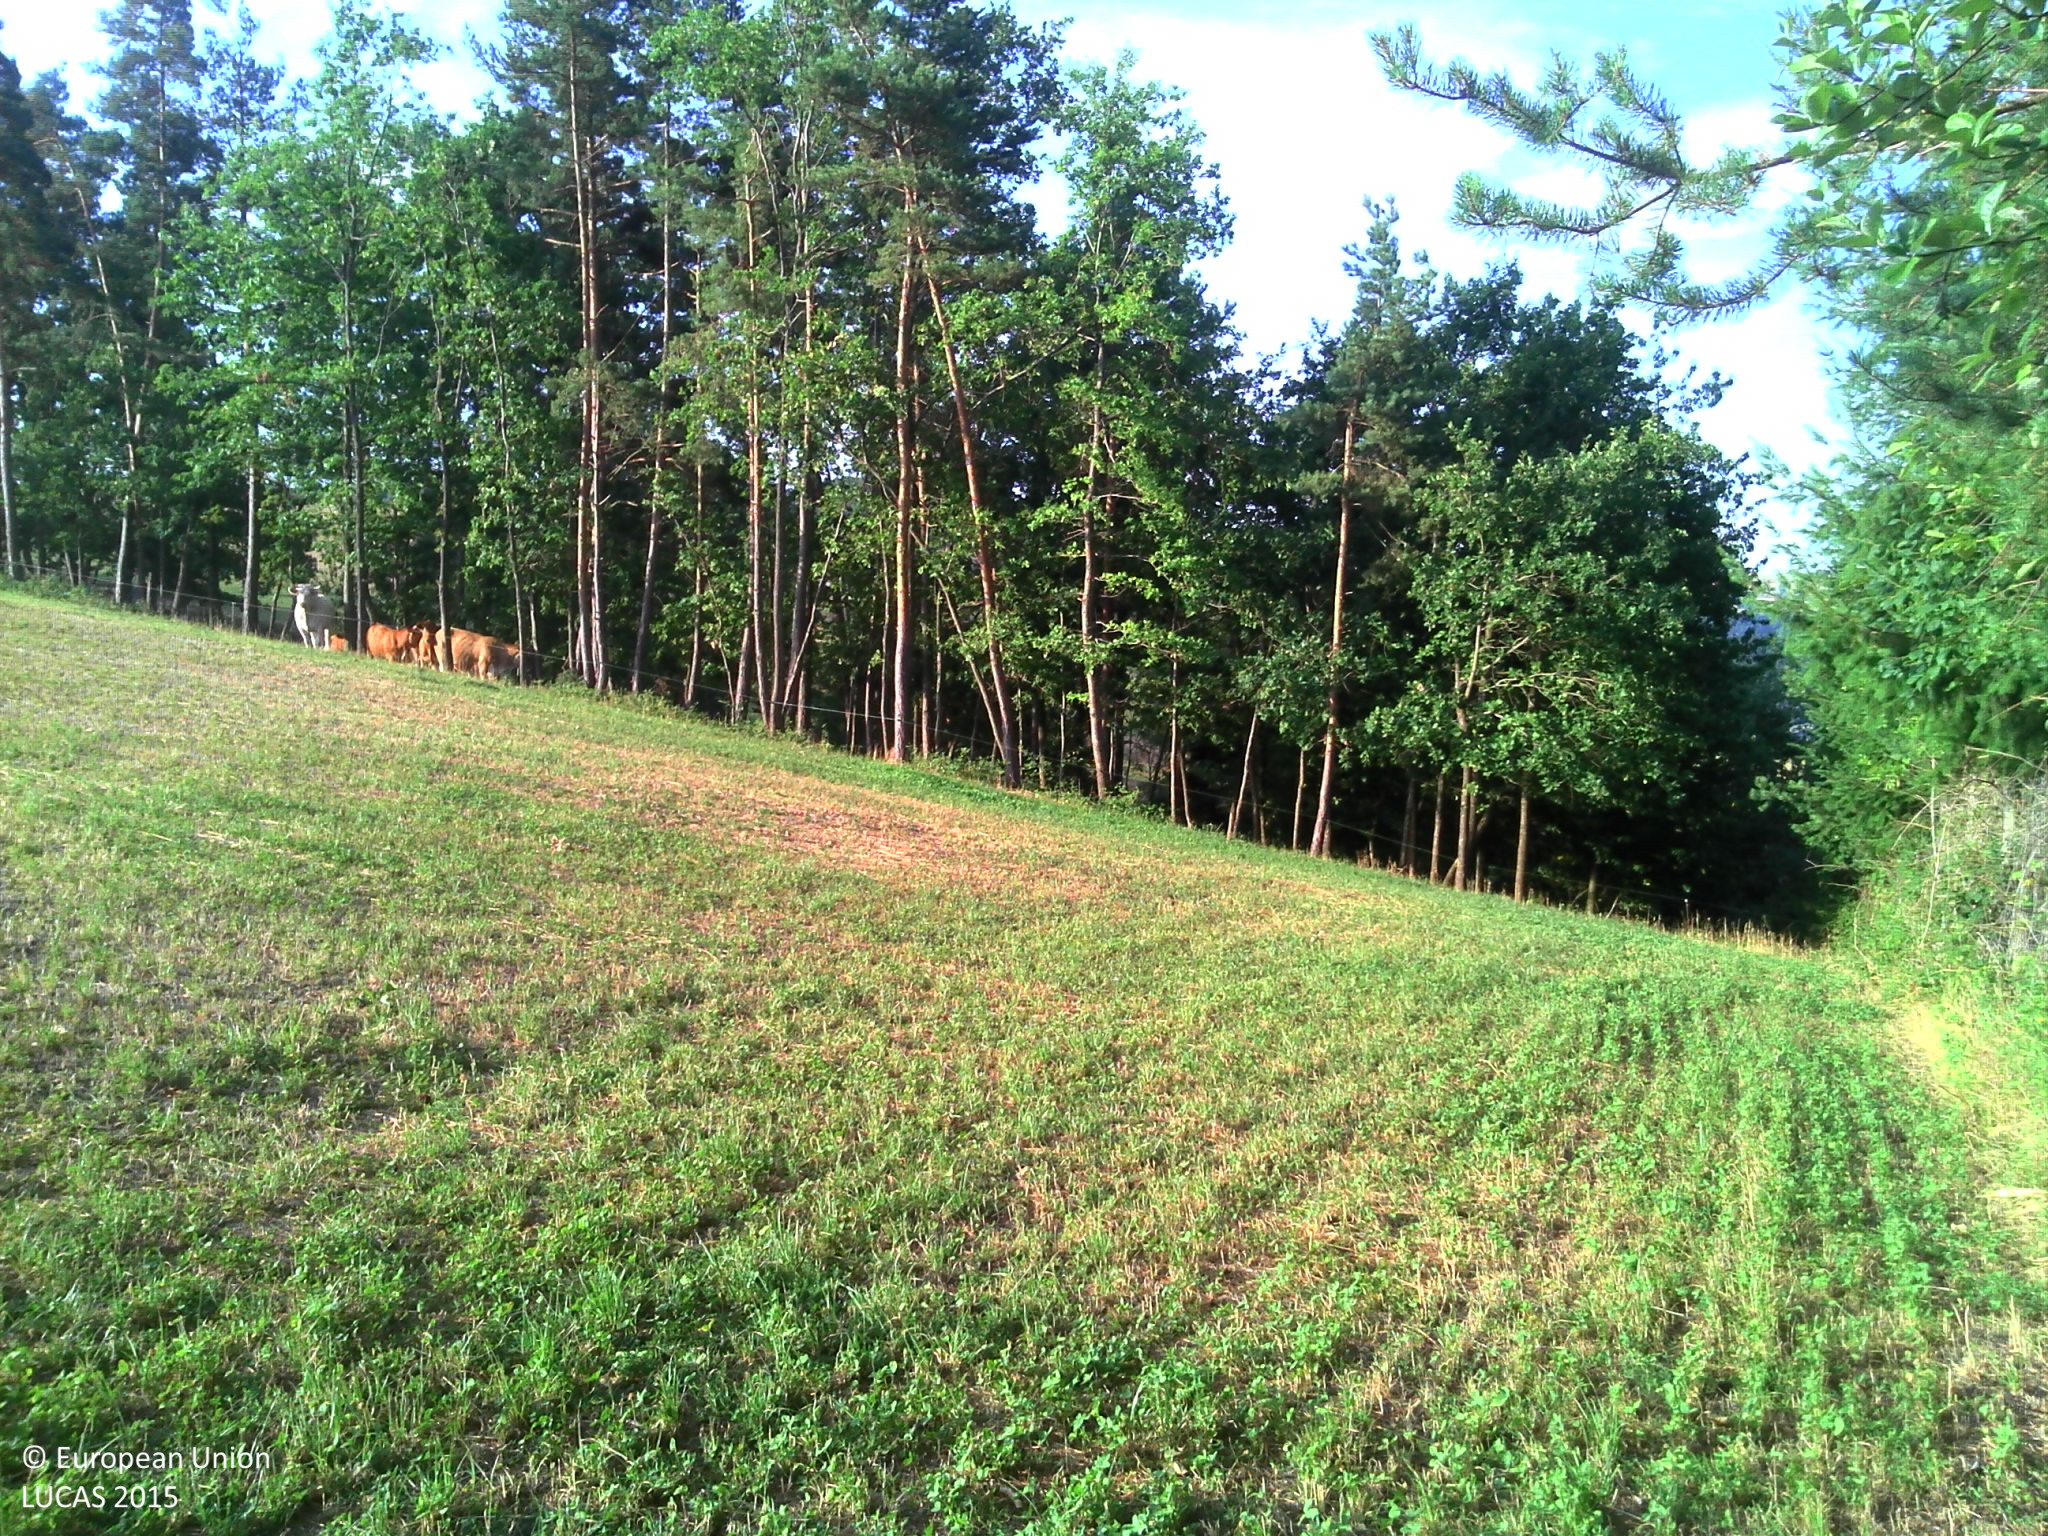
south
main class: Woodland
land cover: Pine dominated mixed woodland
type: exotic forest
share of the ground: > 75 %
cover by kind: broadleaved forest trees 50 %, coniferous forest trees 30 %, herbaceous plants 20 %
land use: Forestry
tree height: > 5 m
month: July
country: FR
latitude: 45.2701
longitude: 4.1536
